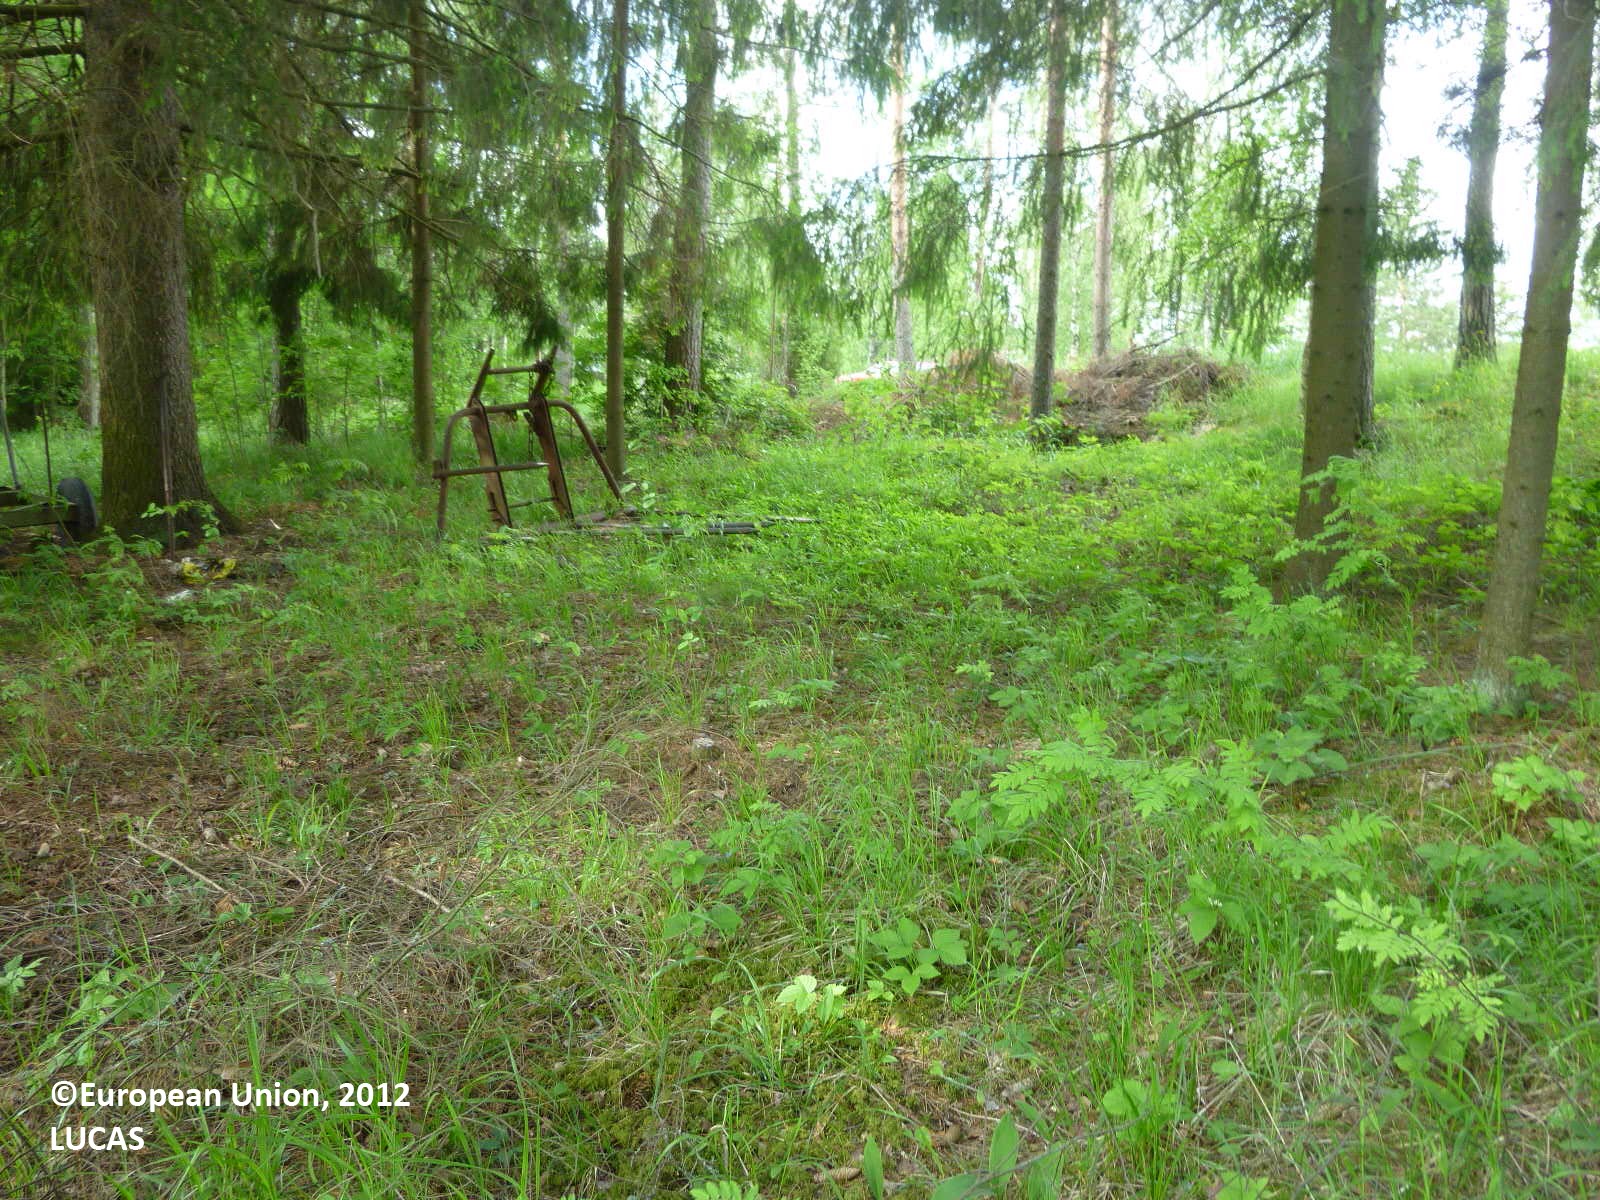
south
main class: Woodland
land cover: Spruce dominated coniferous woodland
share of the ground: > 75 %
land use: Forestry
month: June
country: FI
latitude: 61.3977
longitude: 22.6688
